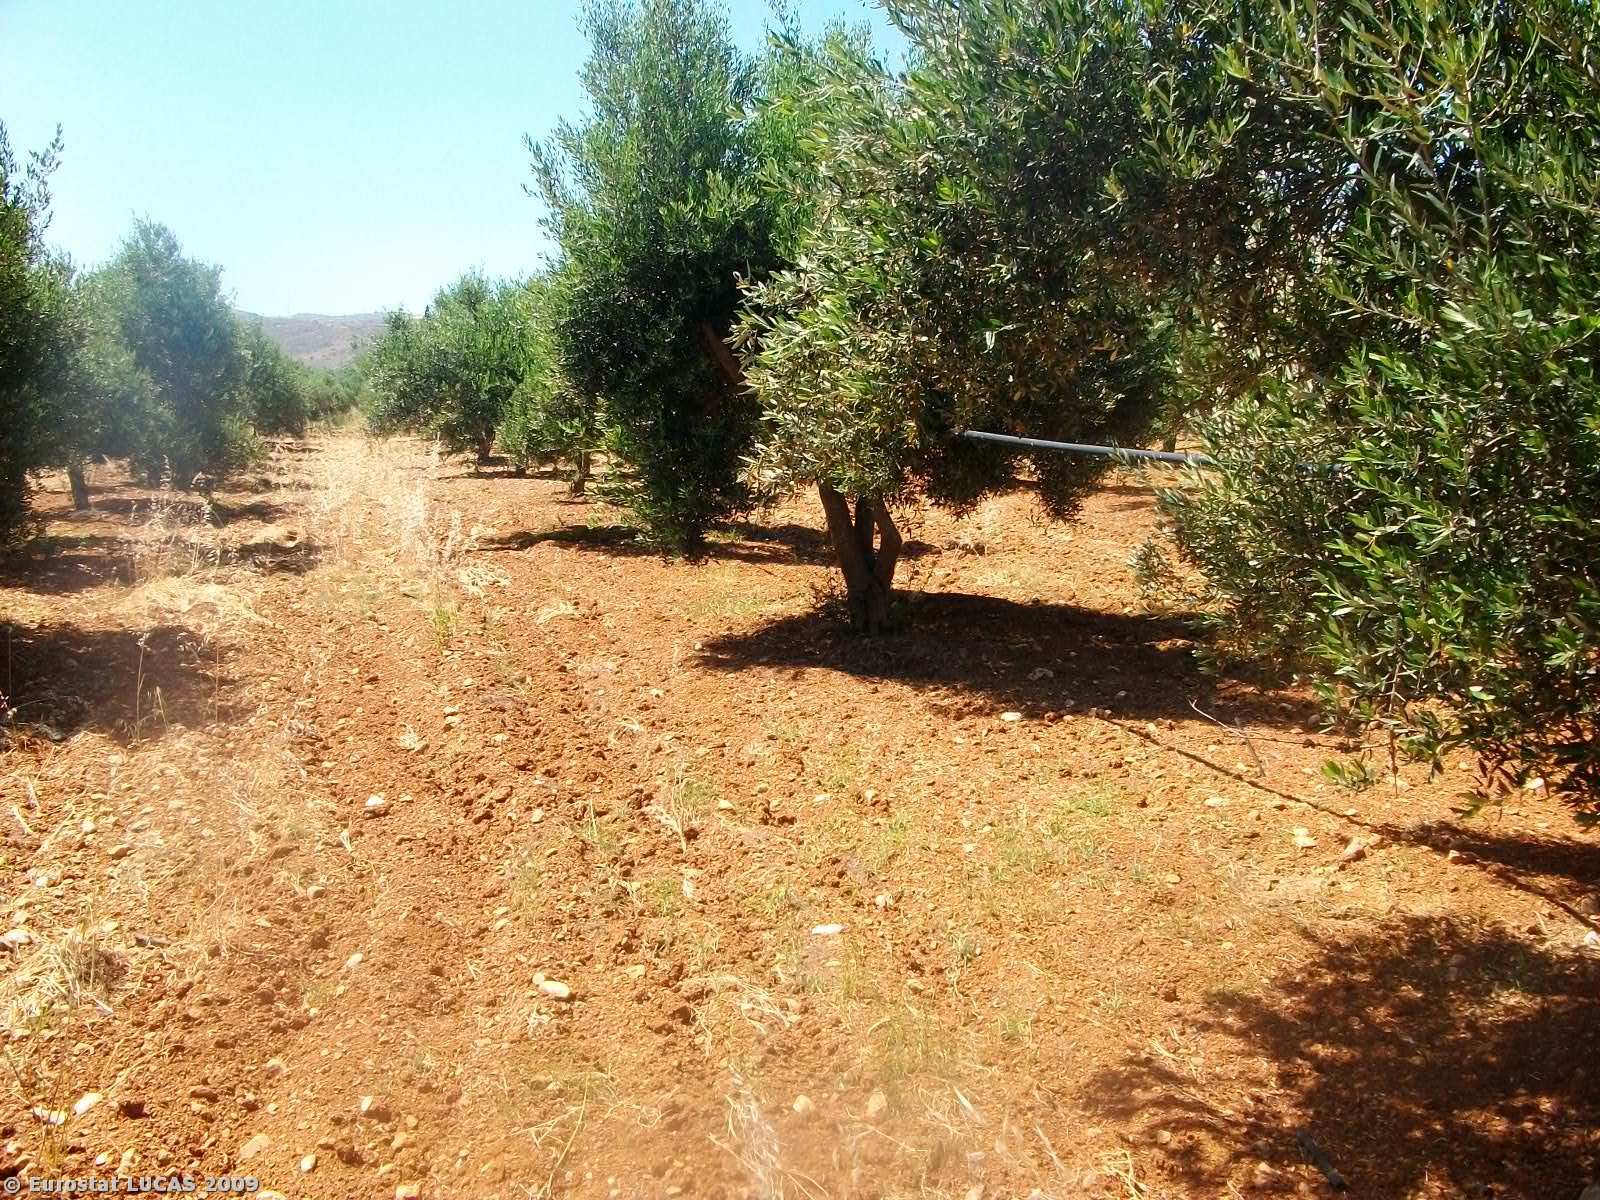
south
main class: Cropland
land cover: Olive groves
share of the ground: > 75 %
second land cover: Bare land
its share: > 75 %
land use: Agriculture (excluding fallow land and kitchen gardens)
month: June
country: GR
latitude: 35.0155
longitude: 24.9214
